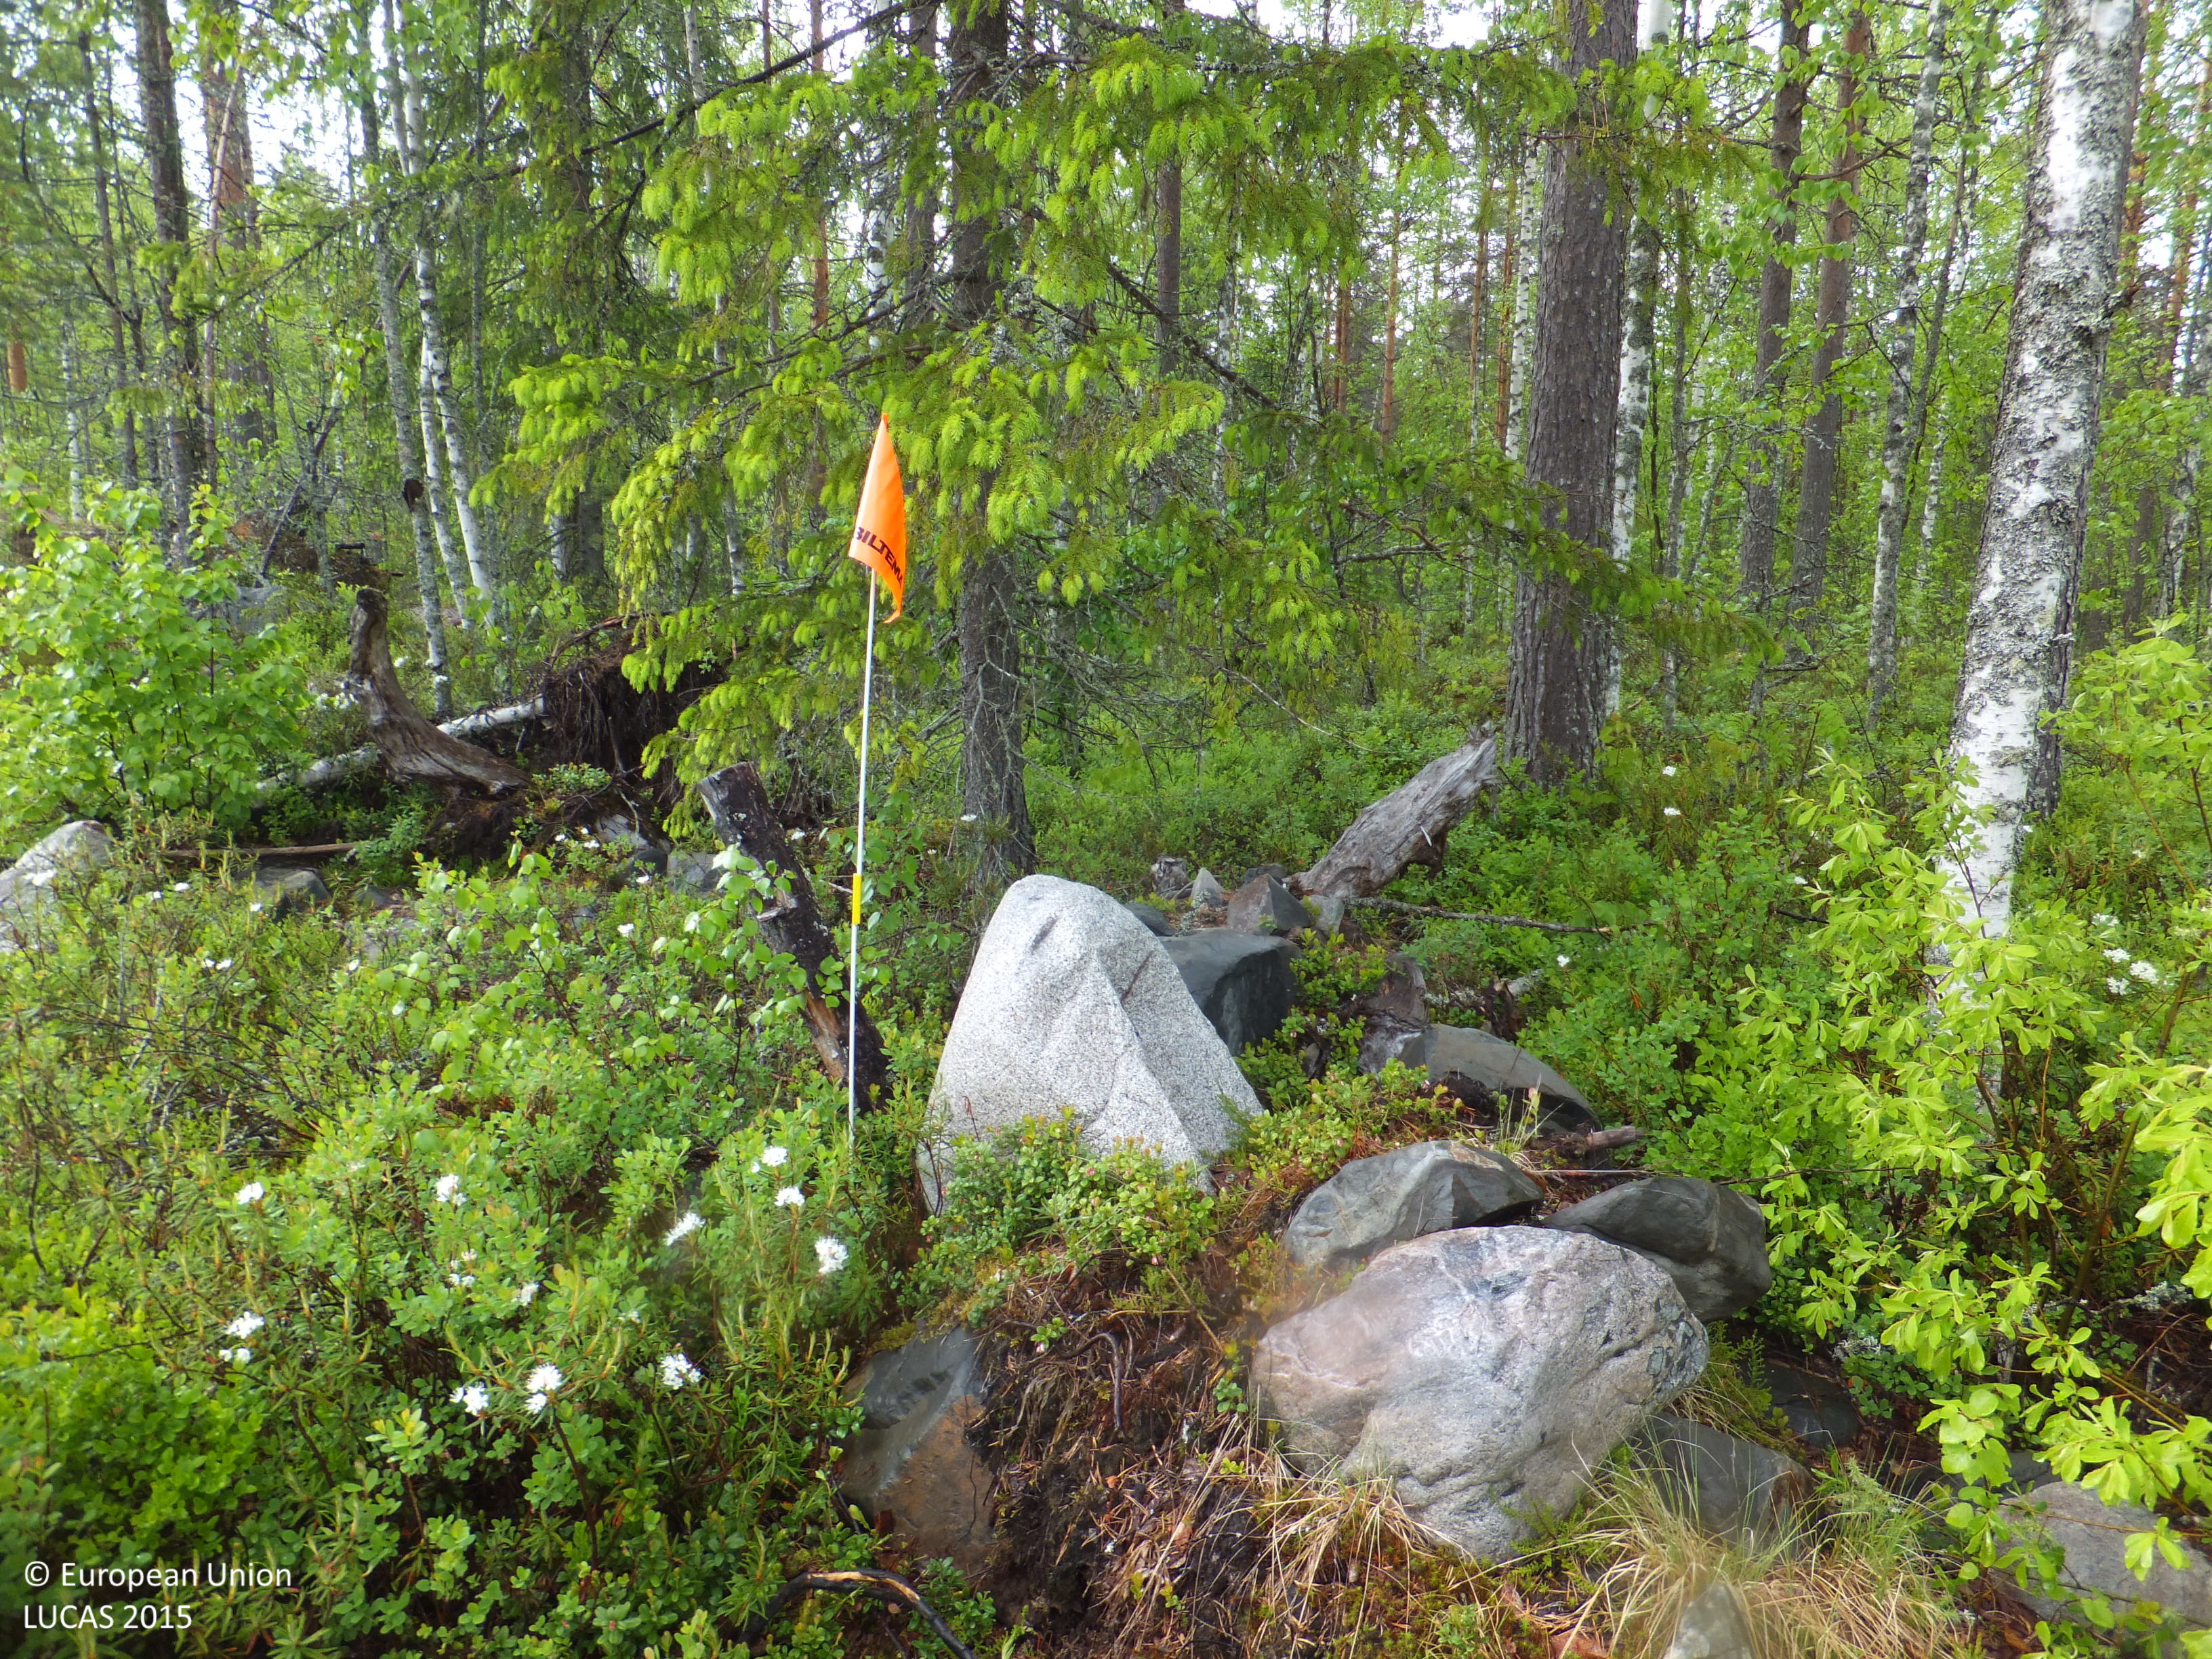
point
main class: Woodland
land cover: Pine dominated mixed woodland
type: boreal forest
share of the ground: > 75 %
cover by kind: broadleaved forest trees 45 %, coniferous forest trees 30 %, shrubs 10 %, lichens and mosses 5 %, consolidated bare surface 5 %, unconsolidated bare surface 5 %
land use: Forestry
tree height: > 5 m
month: June
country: FI
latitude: 63.7486
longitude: 24.8571
